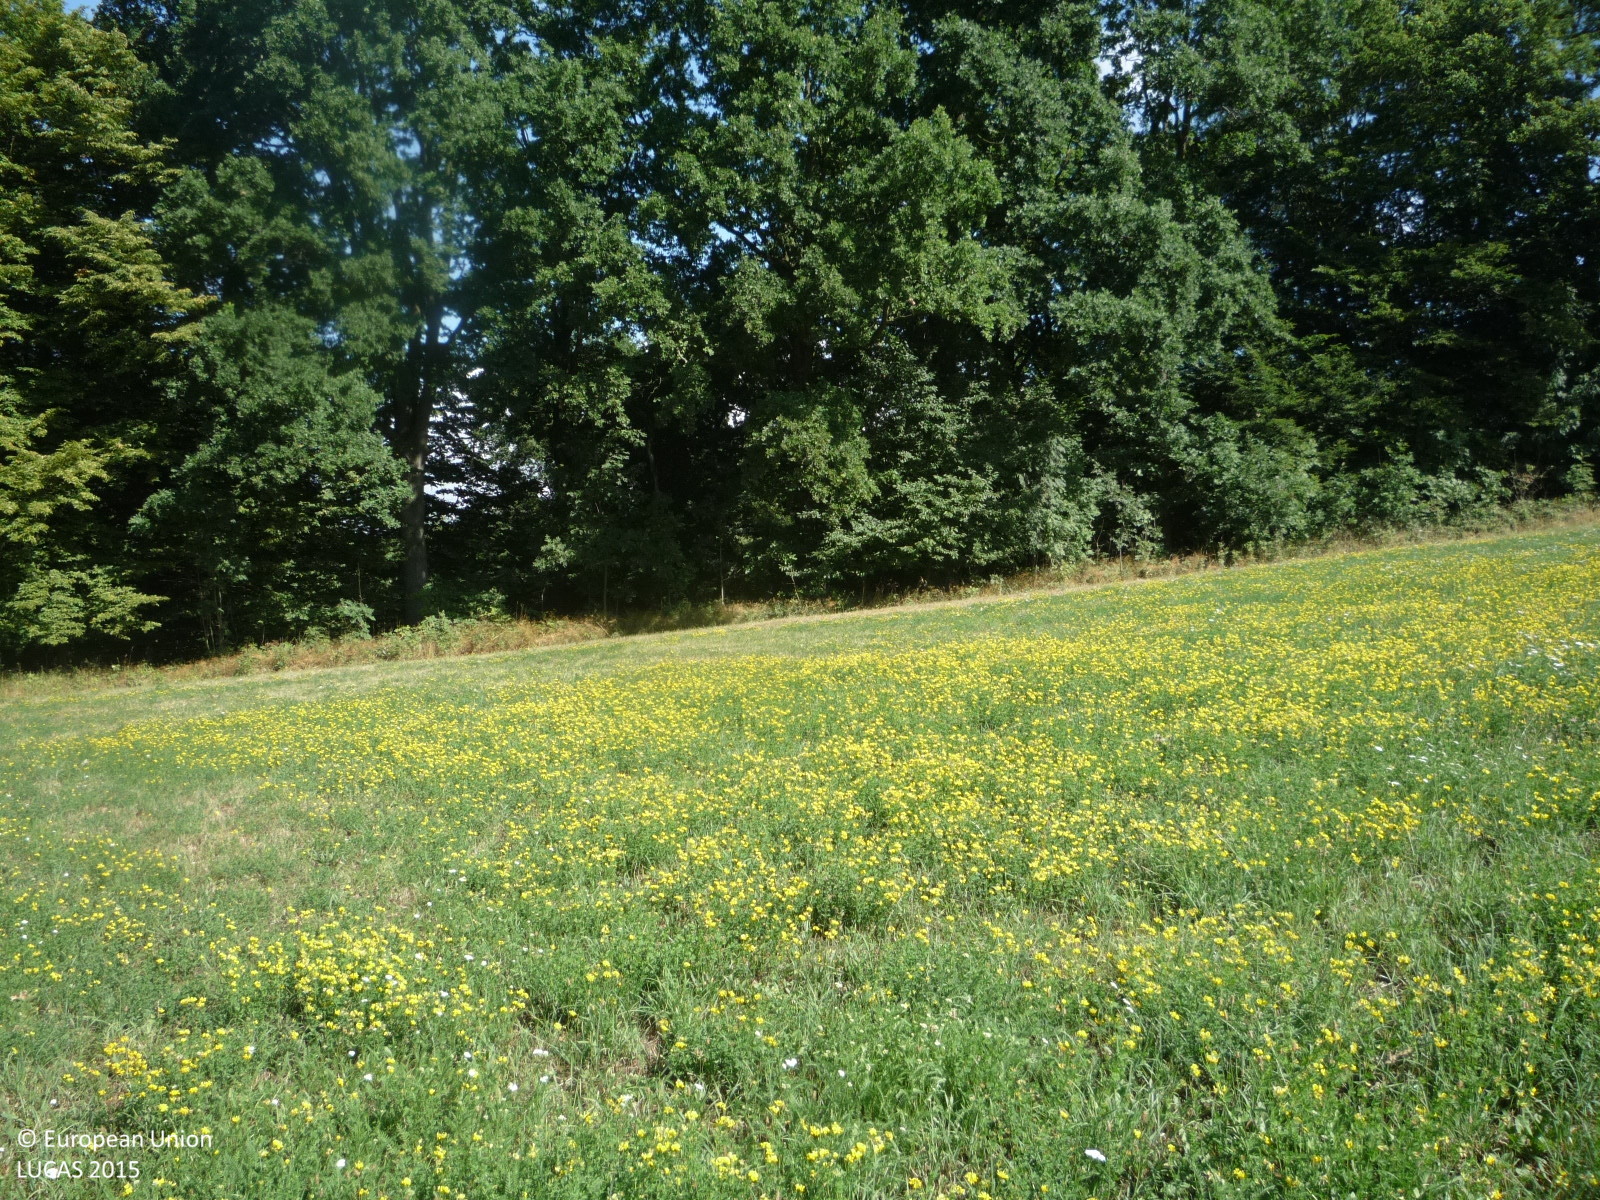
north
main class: Grassland
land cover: Grassland without tree/shrub cover
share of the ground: > 75 %
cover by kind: herbaceous plants 100 %
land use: Agriculture (excluding fallow land and kitchen gardens)
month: July
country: CZ
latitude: 50.5324
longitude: 15.2375
